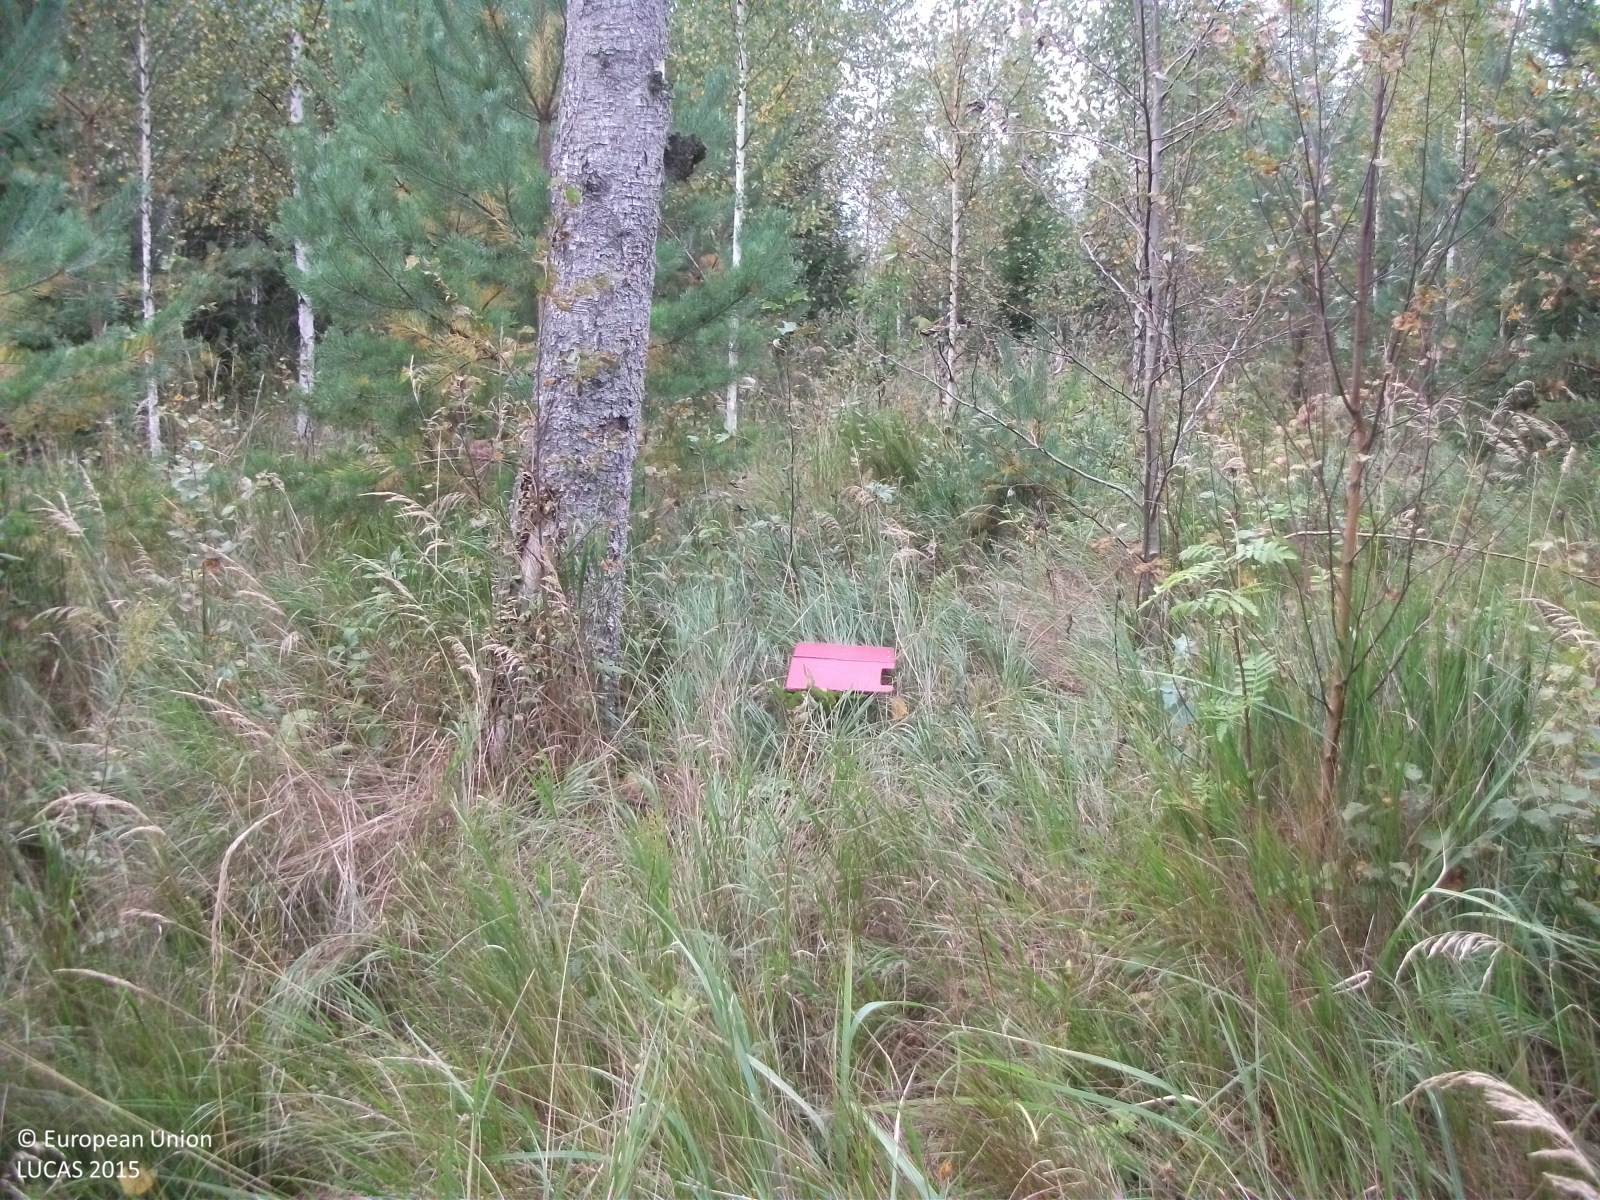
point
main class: Woodland
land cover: Other mixed woodland
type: hemiboreal forest and nemoral coniferous forest and mixed broadleaved-coniferous forest
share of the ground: 50 - 75 %
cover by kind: broadleaved forest trees 45 %, coniferous forest trees 25 %, herbaceous plants 20 %, shrubs 10 %
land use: Forestry
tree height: > 5 m
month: September
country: LV
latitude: 57.7644
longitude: 24.5979
